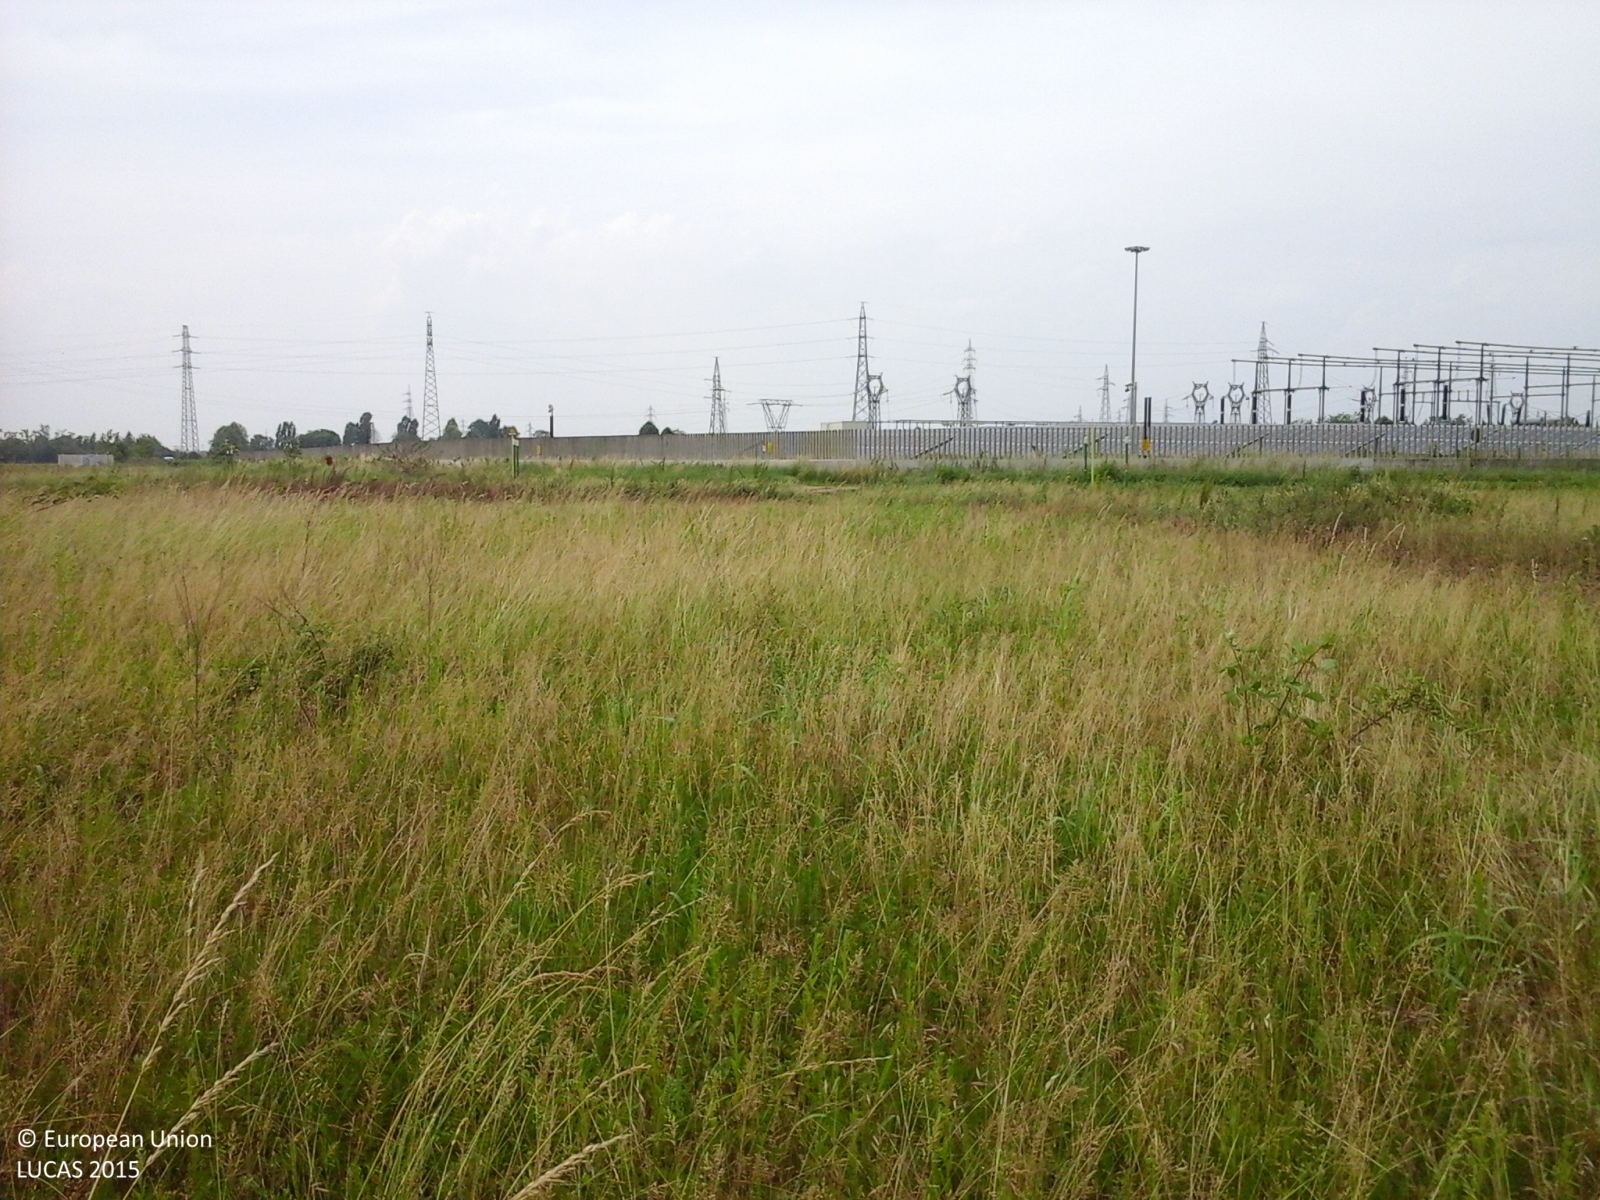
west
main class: Artificial land
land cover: Other artificial areas
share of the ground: > 75 %
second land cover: Spontaneously vegetated surfaces
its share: > 75 %
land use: Electricity, gas and thermal power distribution
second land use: Sport
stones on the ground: > 50 %
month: May
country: IT
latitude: 45.5757
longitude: 9.6034
